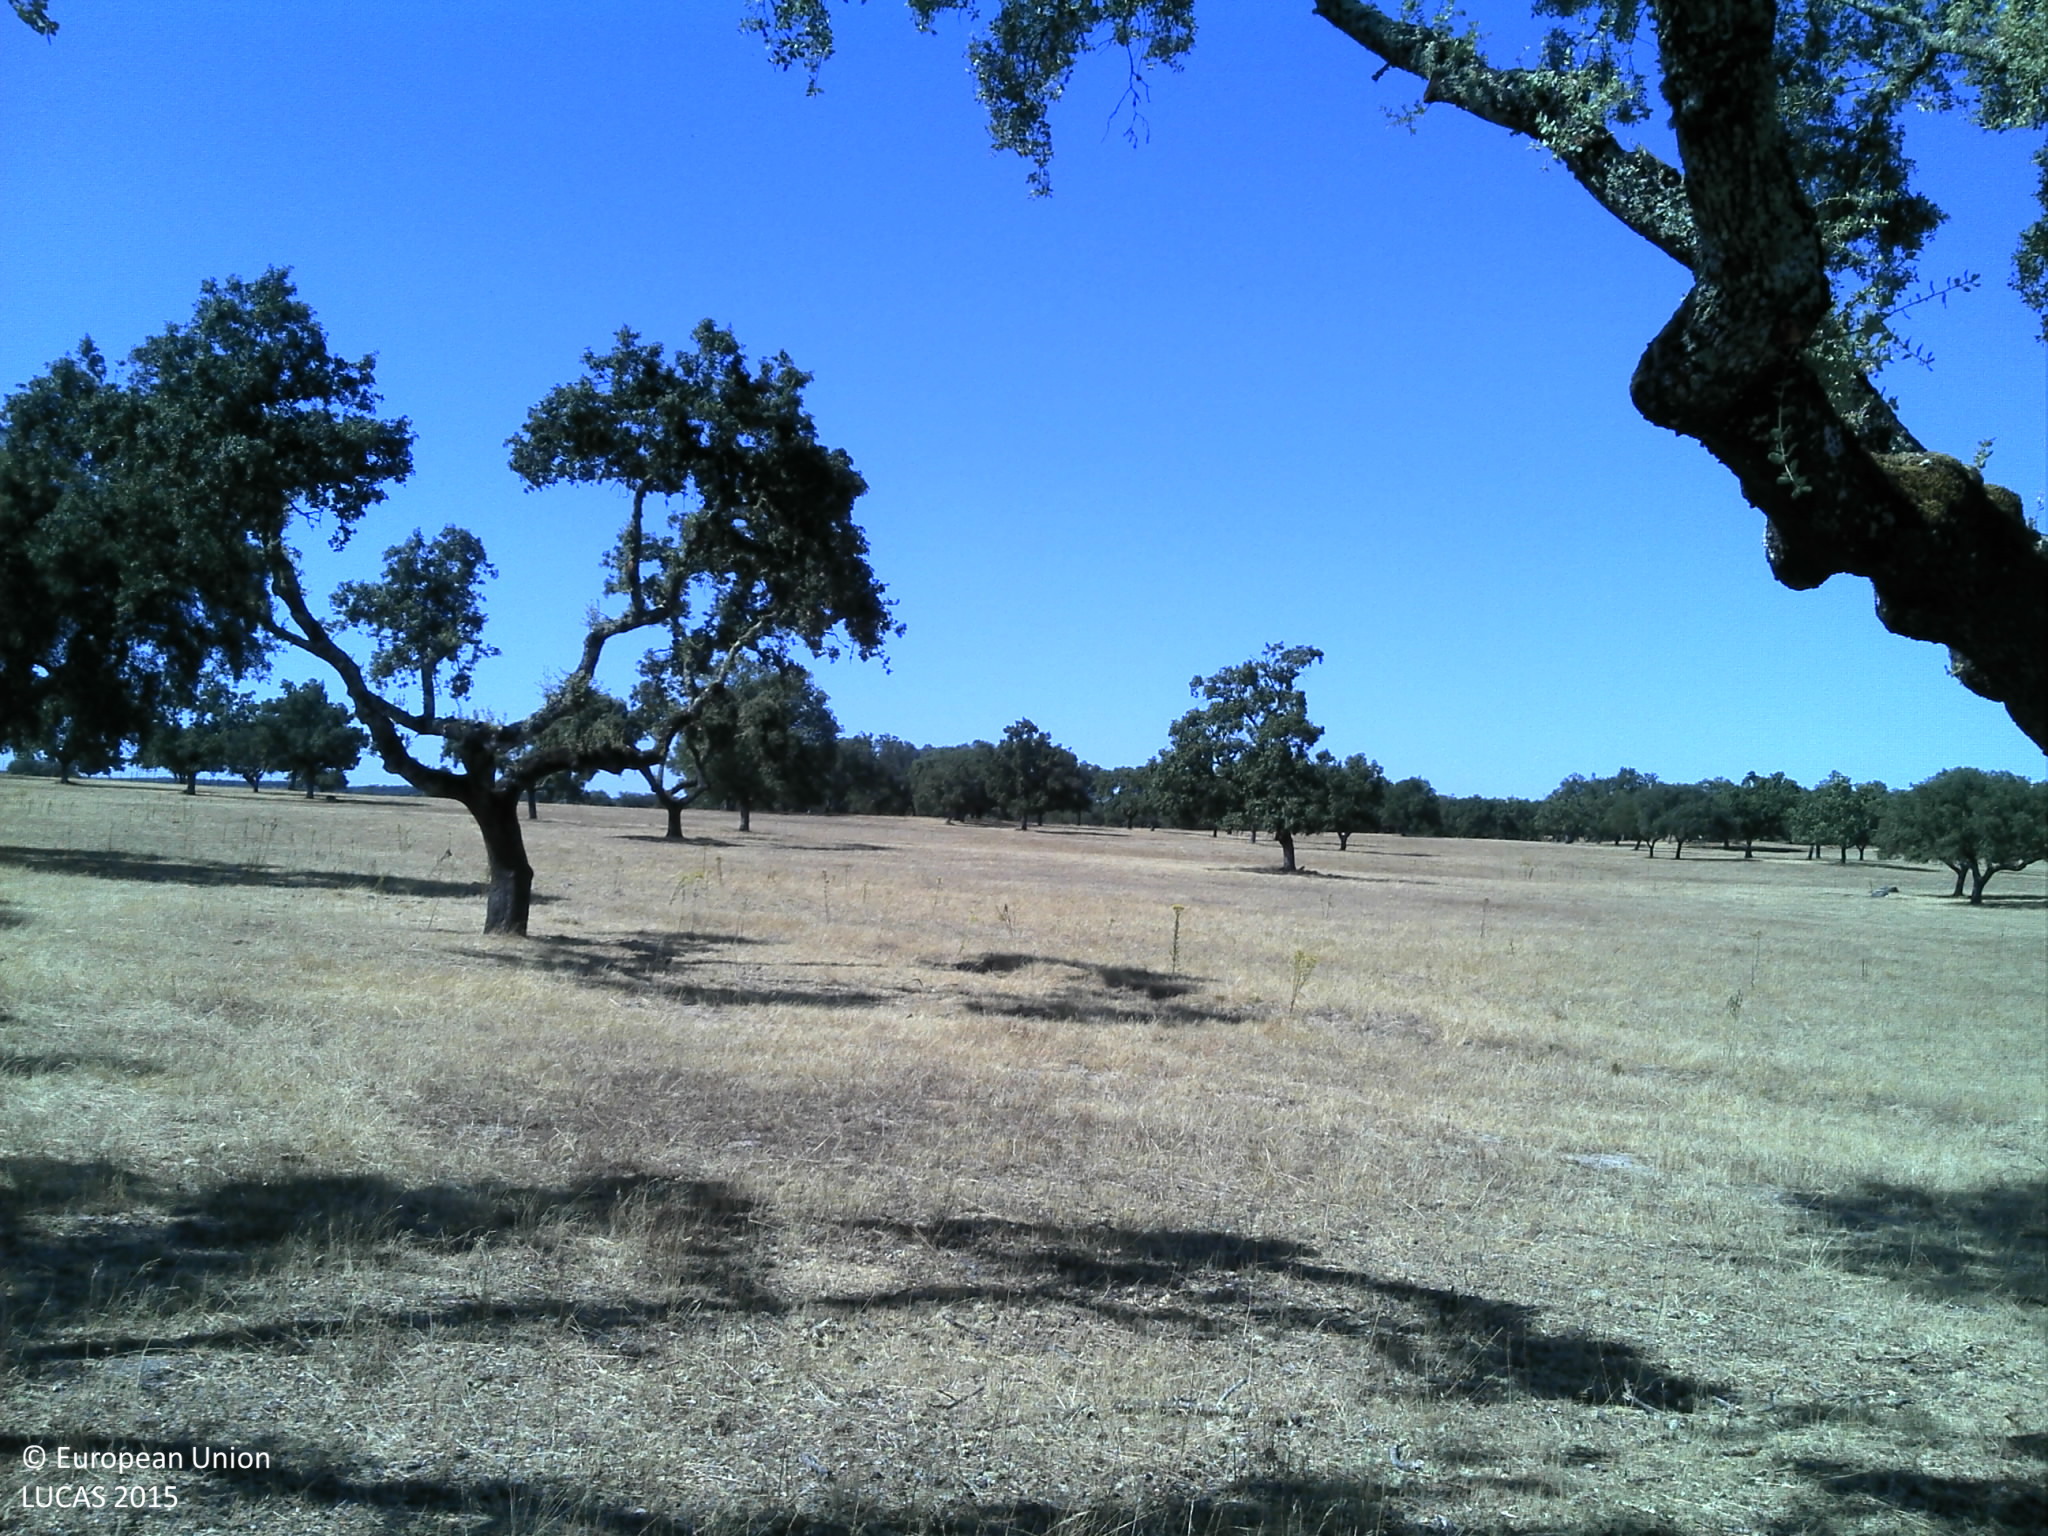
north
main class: Woodland
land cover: Broadleaved woodland
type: broadleaved evergreen forest
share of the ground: 25 - 50 %
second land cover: Grassland without tree/shrub cover
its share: 10 - 25 %
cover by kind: unconsolidated bare surface 50 %, broadleaved forest trees 30 %, herbaceous plants 20 %
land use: Forestry
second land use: Agriculture (excluding fallow land and kitchen gardens)
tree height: > 5 m
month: July
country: PT
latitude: 39.3408
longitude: -7.6248
